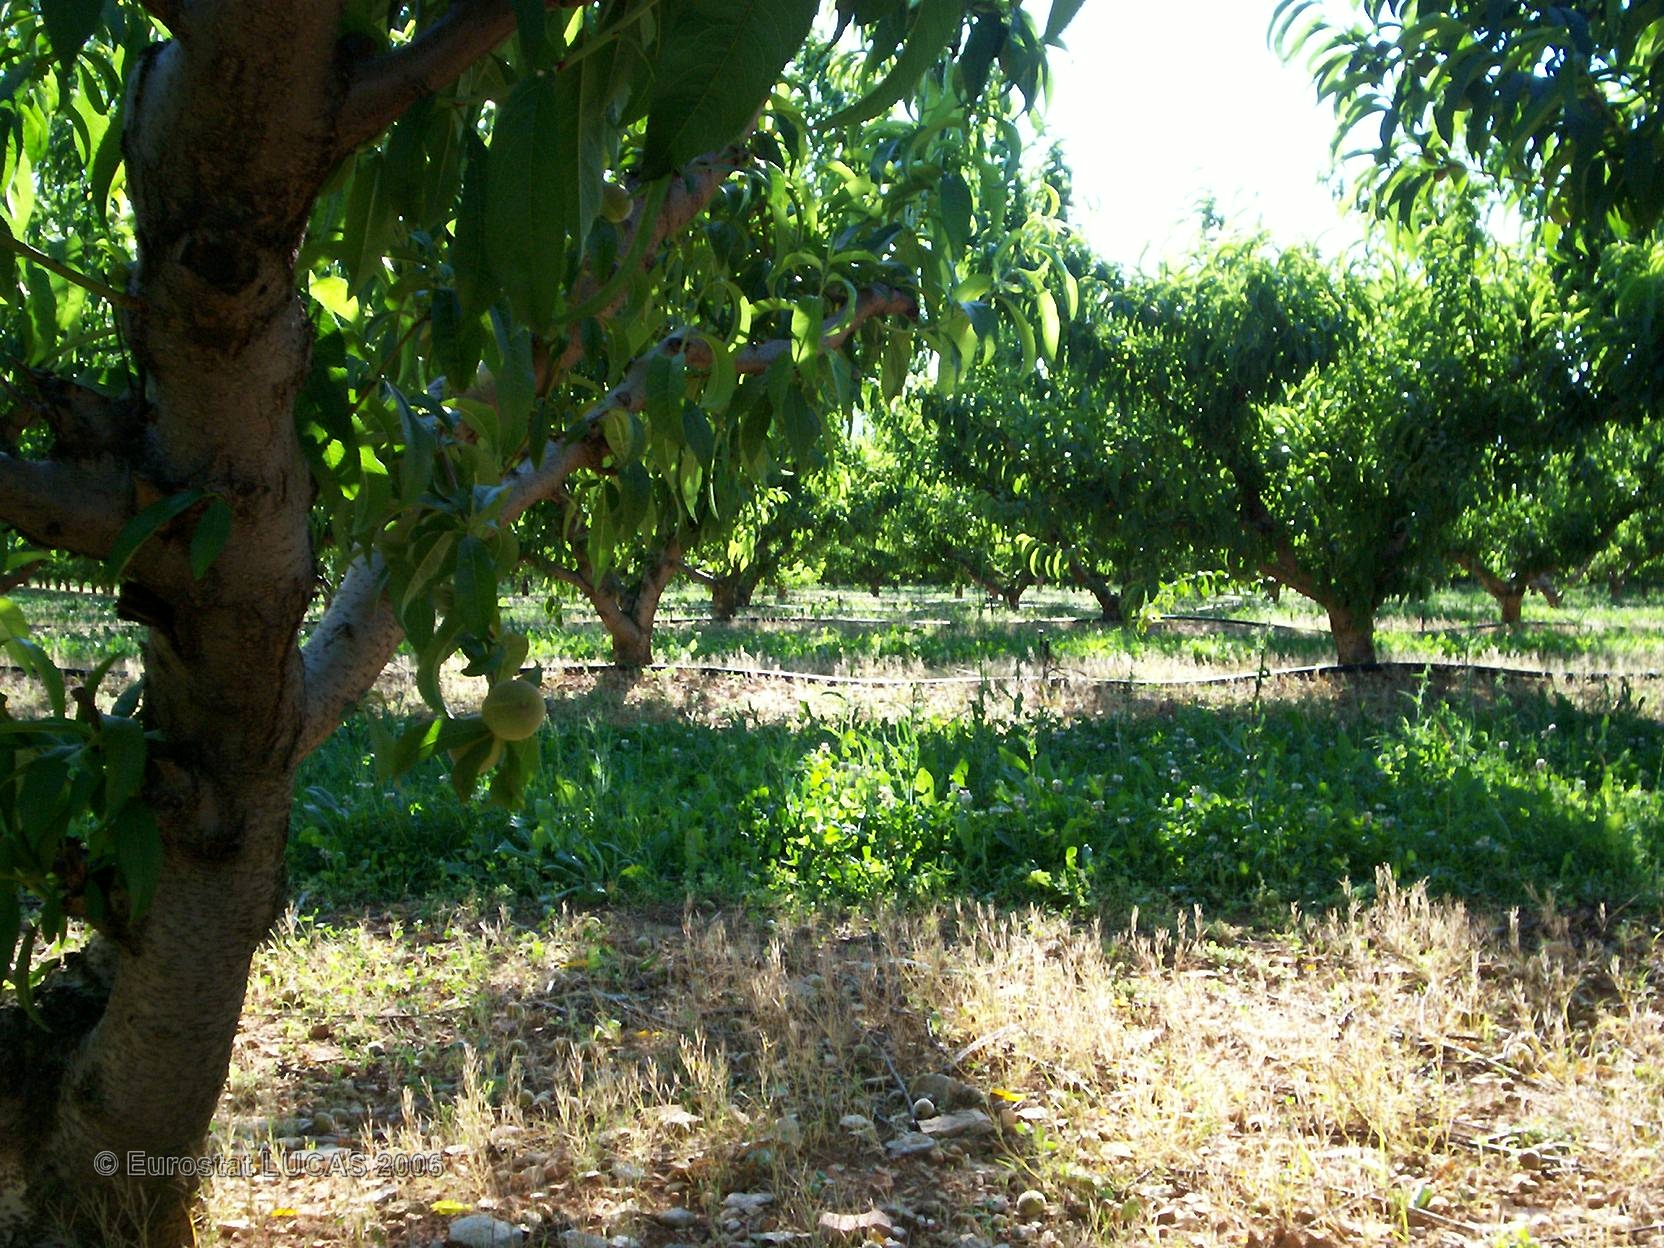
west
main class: Cropland
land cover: Other fruit trees and berries
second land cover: Grassland with sparse tree/shrub cover
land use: Agriculture (excluding fallow land and kitchen gardens)
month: May
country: FR
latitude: 44.6910
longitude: 4.8203
